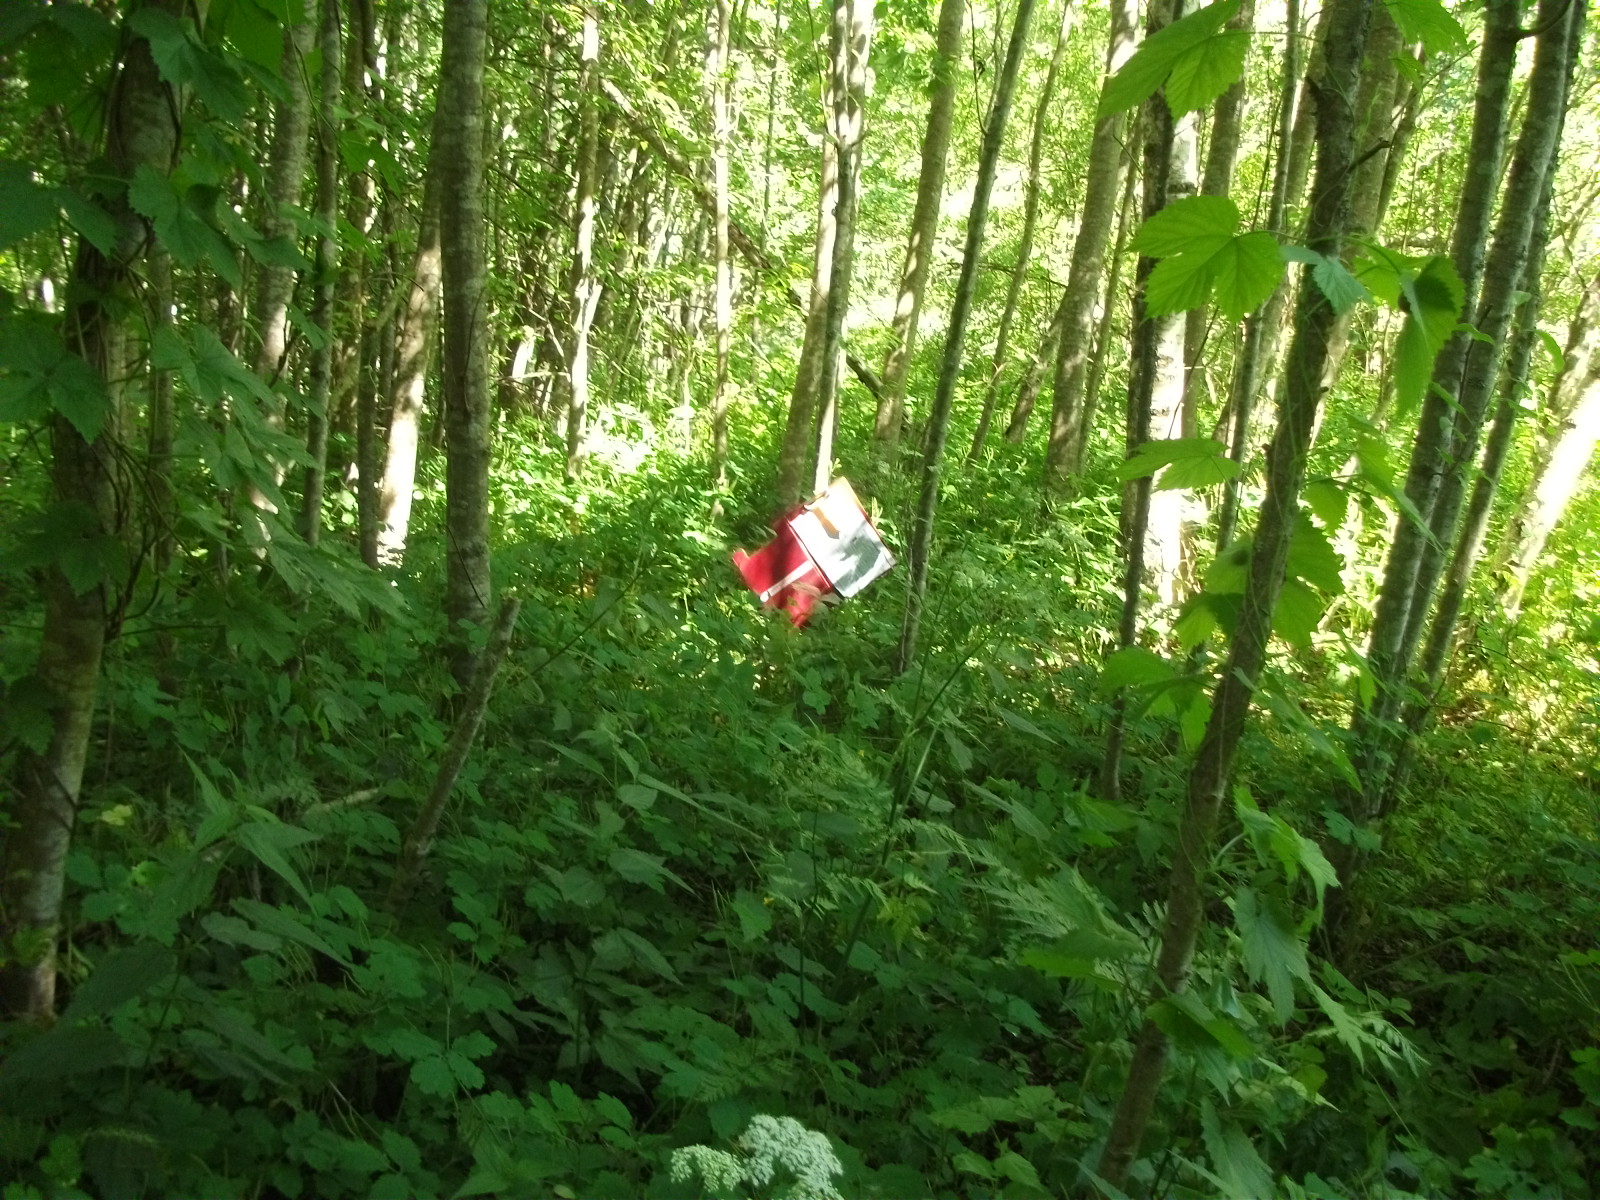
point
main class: Woodland
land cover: Broadleaved woodland
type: non-riverine alder, birch or aspen forest
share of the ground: > 75 %
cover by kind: broadleaved forest trees 100 %
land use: Forestry
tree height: > 5 m
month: July
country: LV
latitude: 56.7330
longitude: 26.1725
